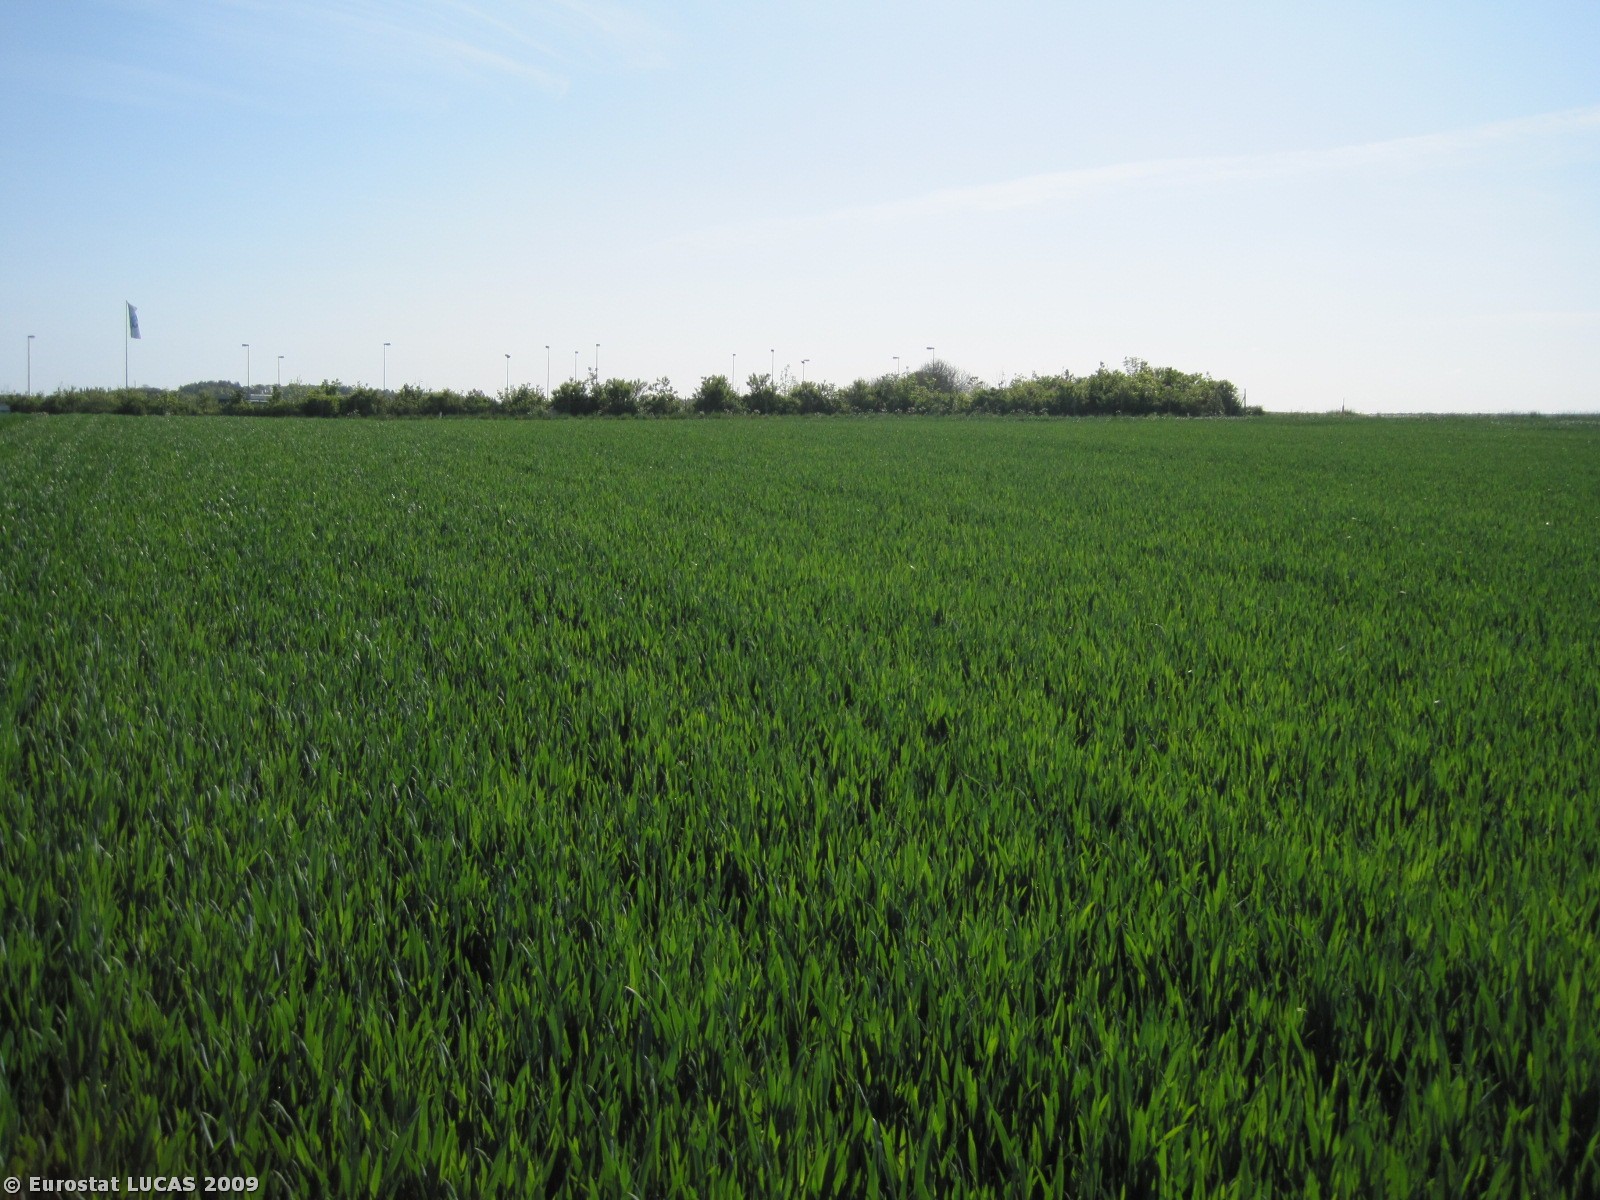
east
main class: Cropland
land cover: Common wheat
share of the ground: > 75 %
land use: Agriculture (excluding fallow land and kitchen gardens)
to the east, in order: Common wheat; Grassland without tree/shrub cover; Paved roads, cycling and walking lanes; Grassland without tree/shrub cover; Fences; Managed hedges; Grassland without tree/shrub cover; Artificial constructions in urban areas
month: May
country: DK
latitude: 56.5651
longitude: 10.1788
